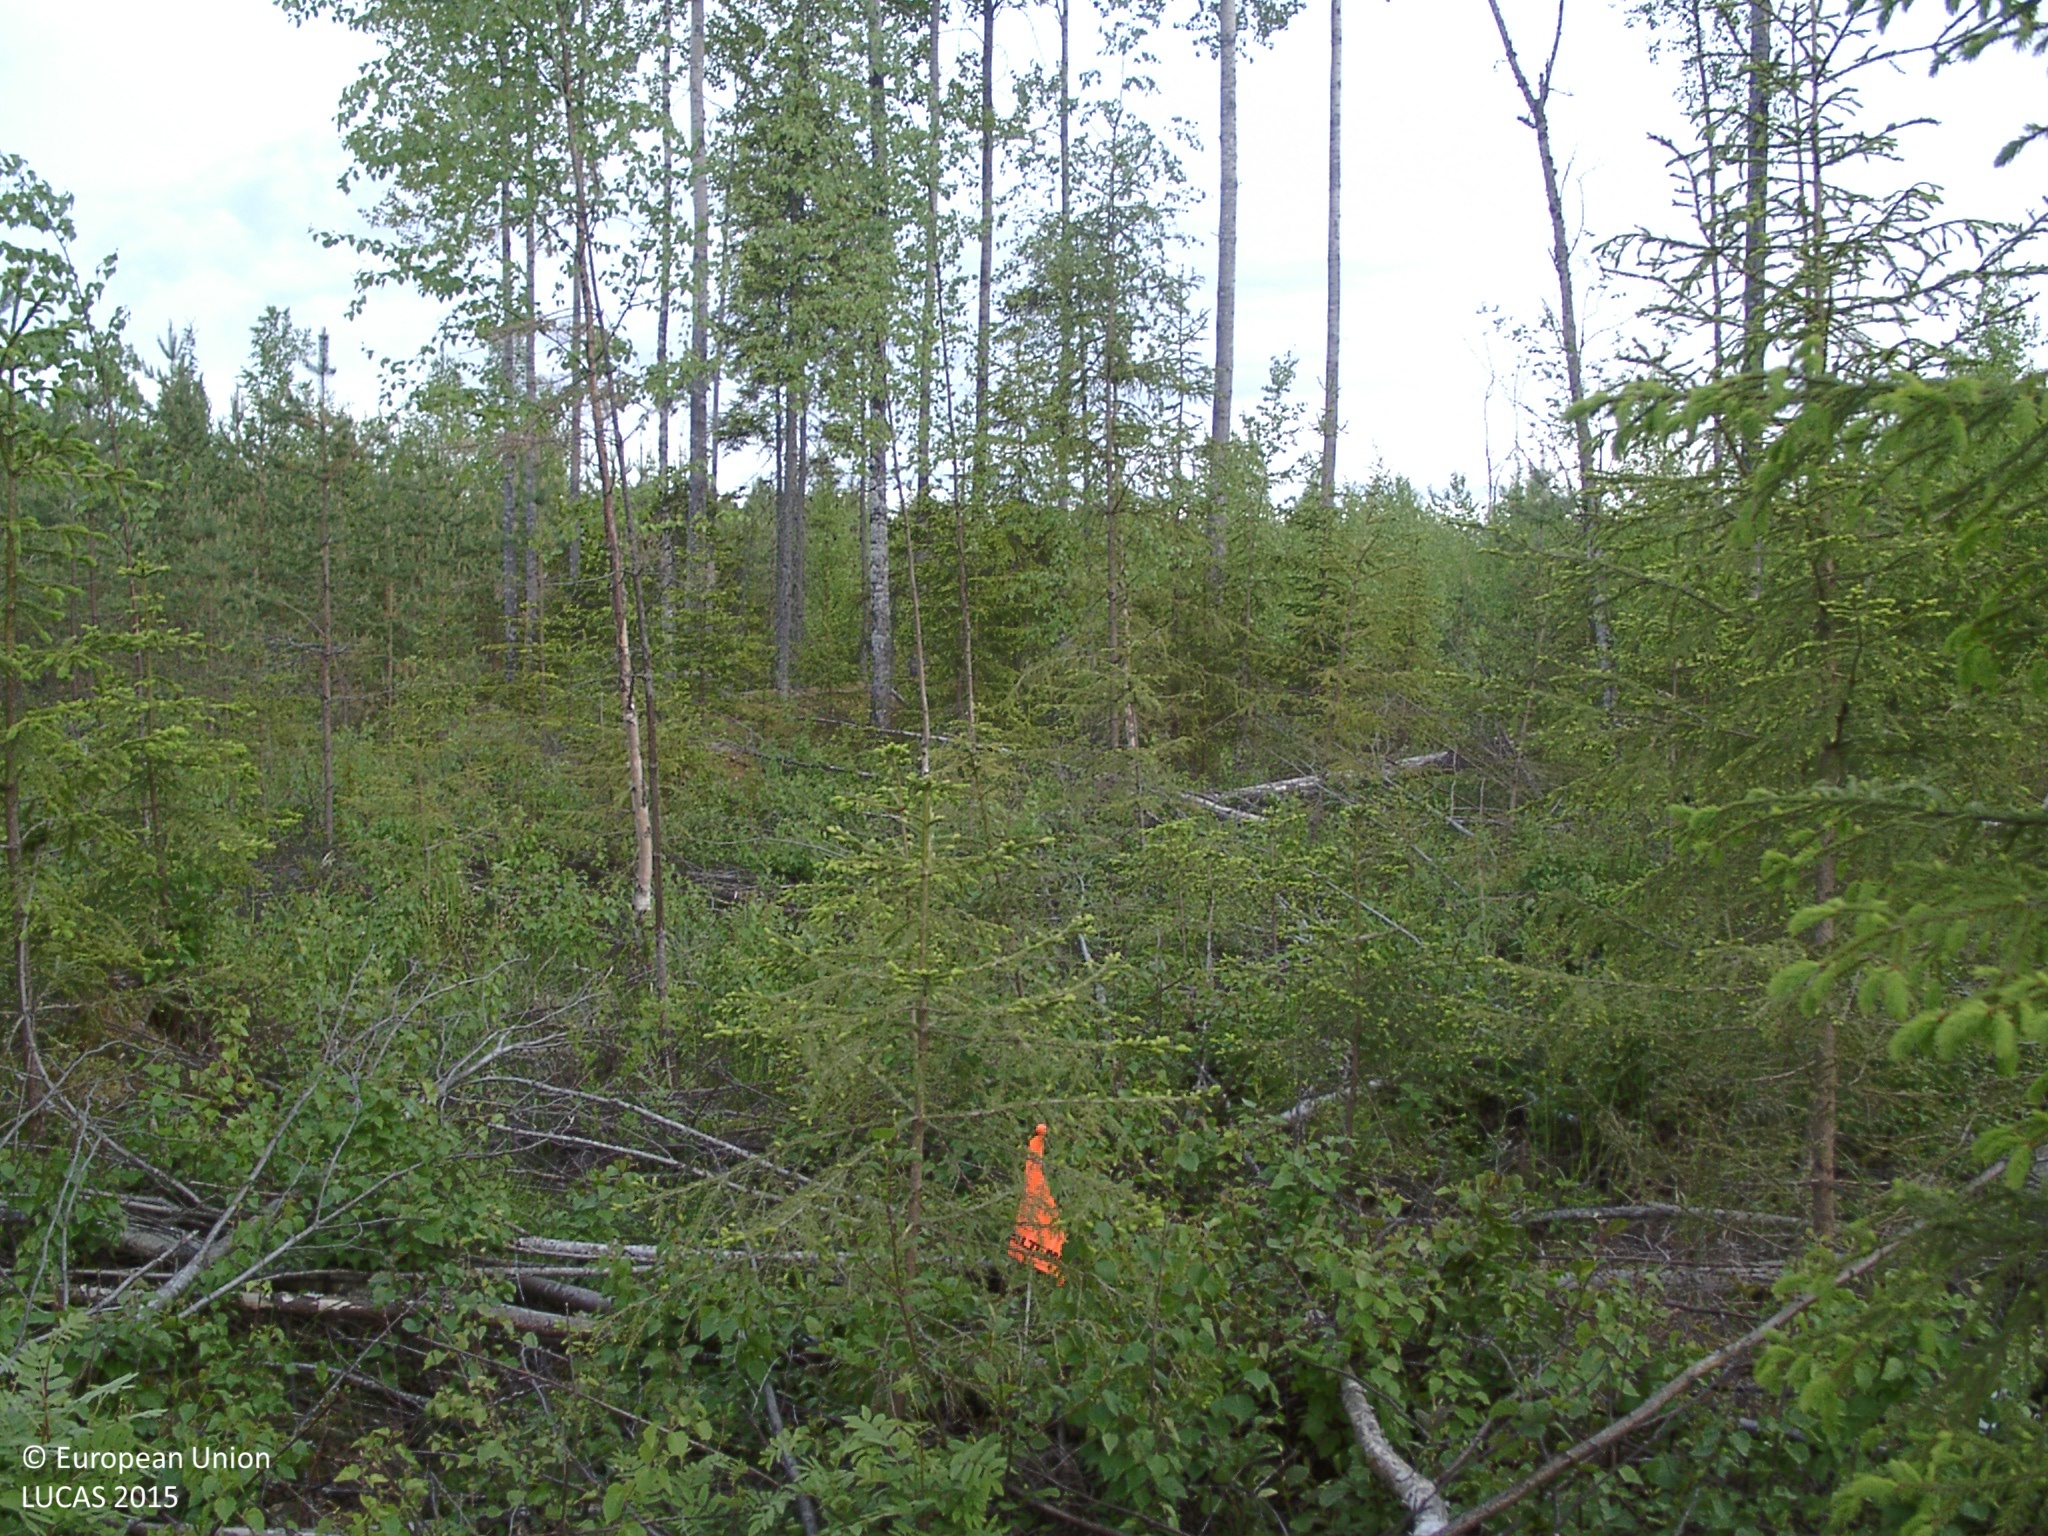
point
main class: Woodland
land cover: Spruce dominated mixed woodland
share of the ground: 50 - 75 %
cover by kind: broadleaved forest trees 40 %, coniferous forest trees 25 %, herbaceous plants 20 %, shrubs 5 %
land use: Forestry
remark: Nursery
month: June
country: FI
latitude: 62.1721
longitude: 26.0078
